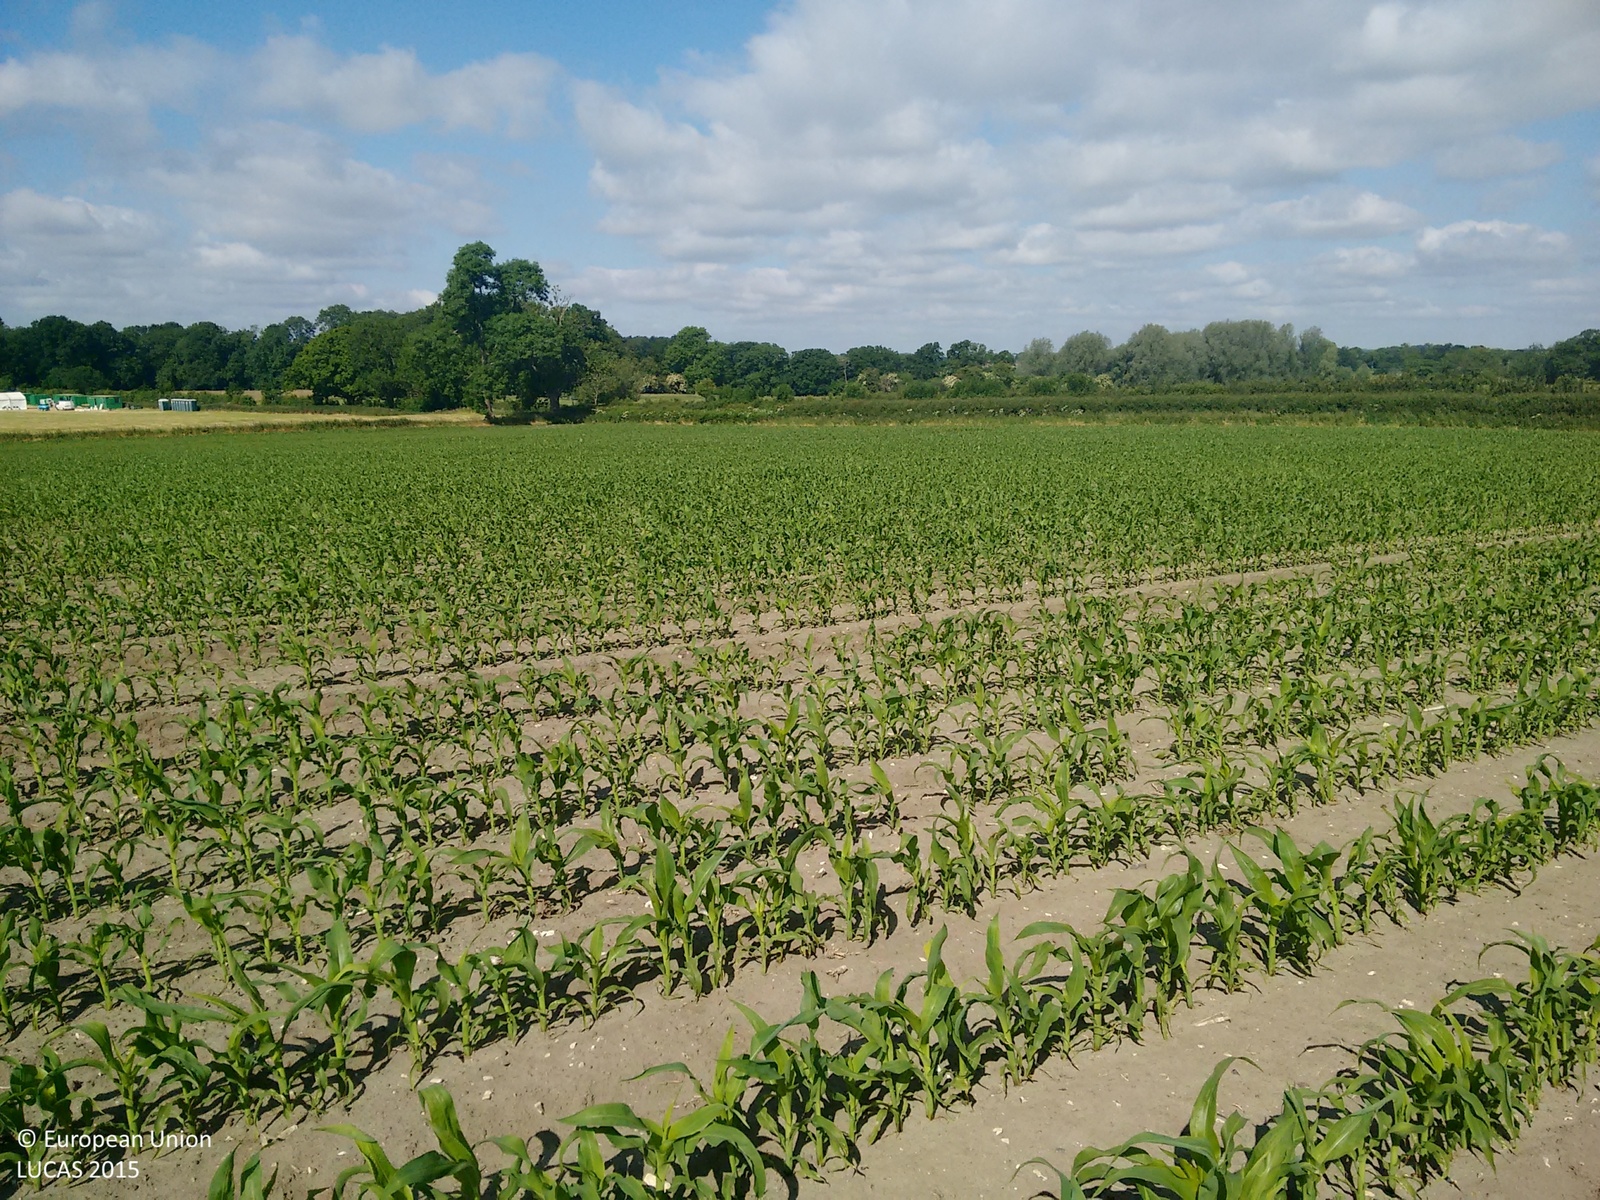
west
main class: Cropland
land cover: Maize
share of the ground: 25 - 50 %
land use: Agriculture (excluding fallow land and kitchen gardens)
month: June
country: GB
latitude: 51.3252
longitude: -1.8669
